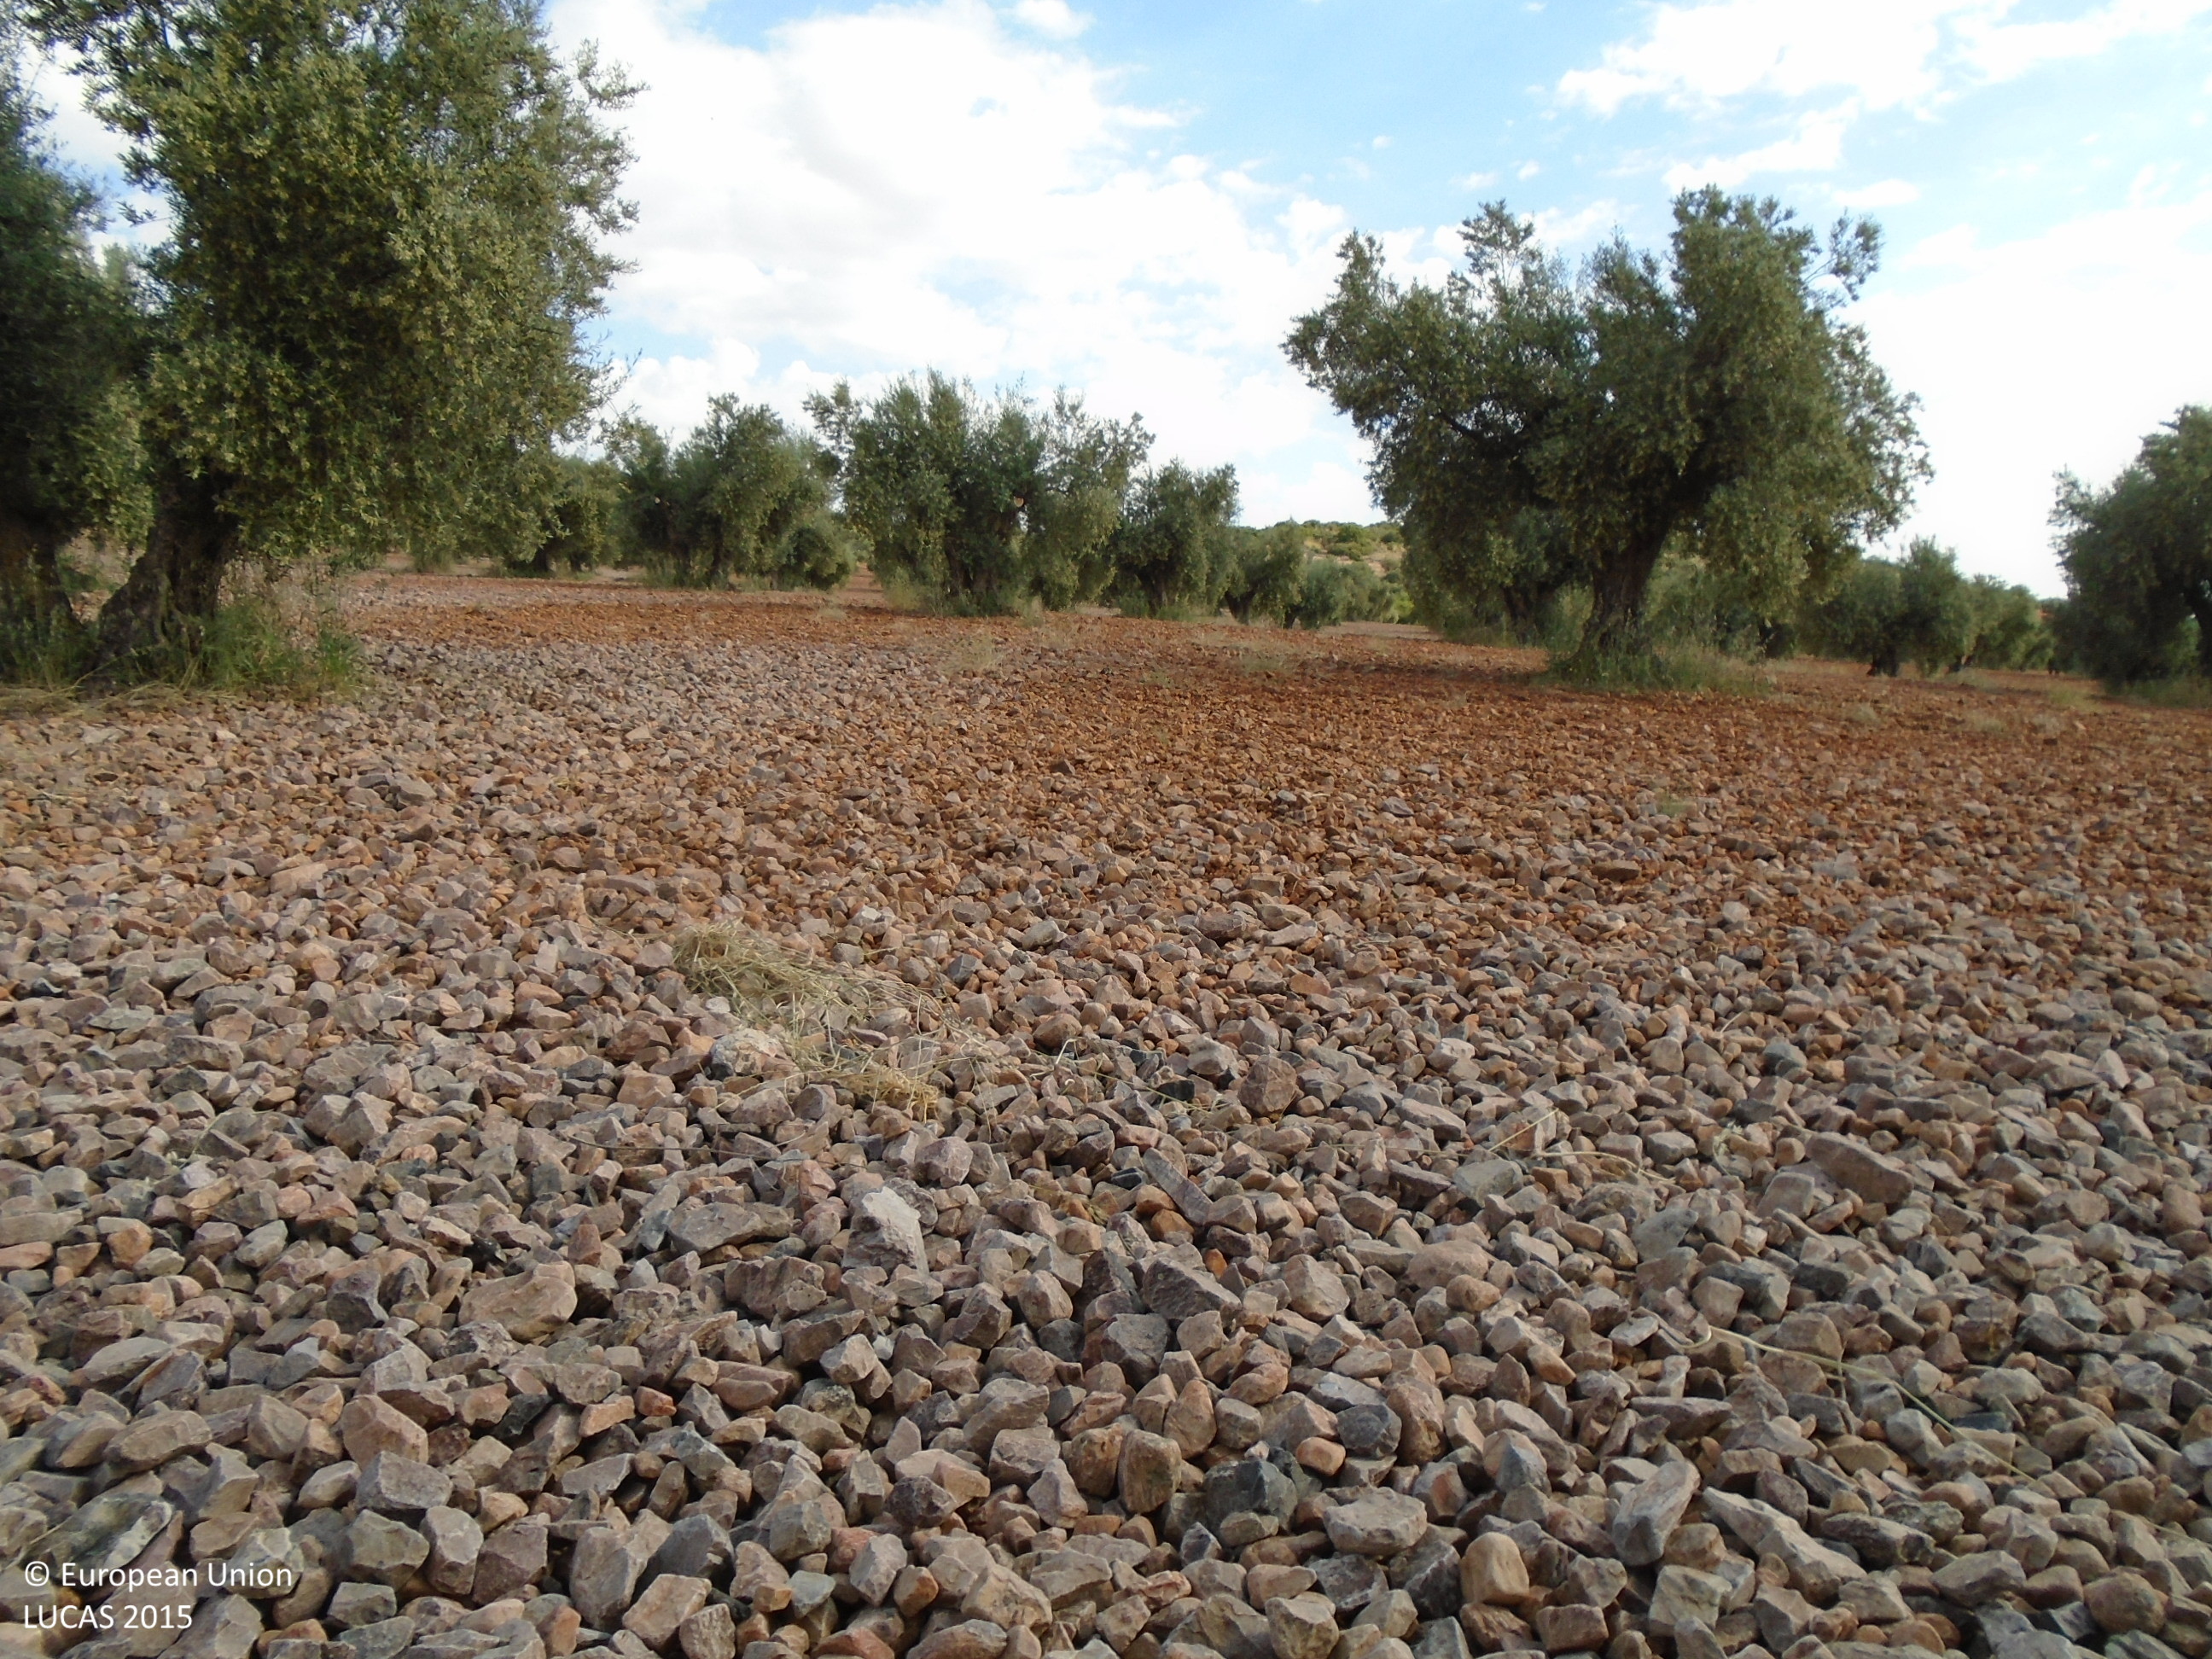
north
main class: Cropland
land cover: Olive groves
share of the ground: 10 - 25 %
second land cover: Other bare soil
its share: > 75 %
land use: Agriculture (excluding fallow land and kitchen gardens)
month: May
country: ES
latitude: 39.5900
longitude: -3.7317
